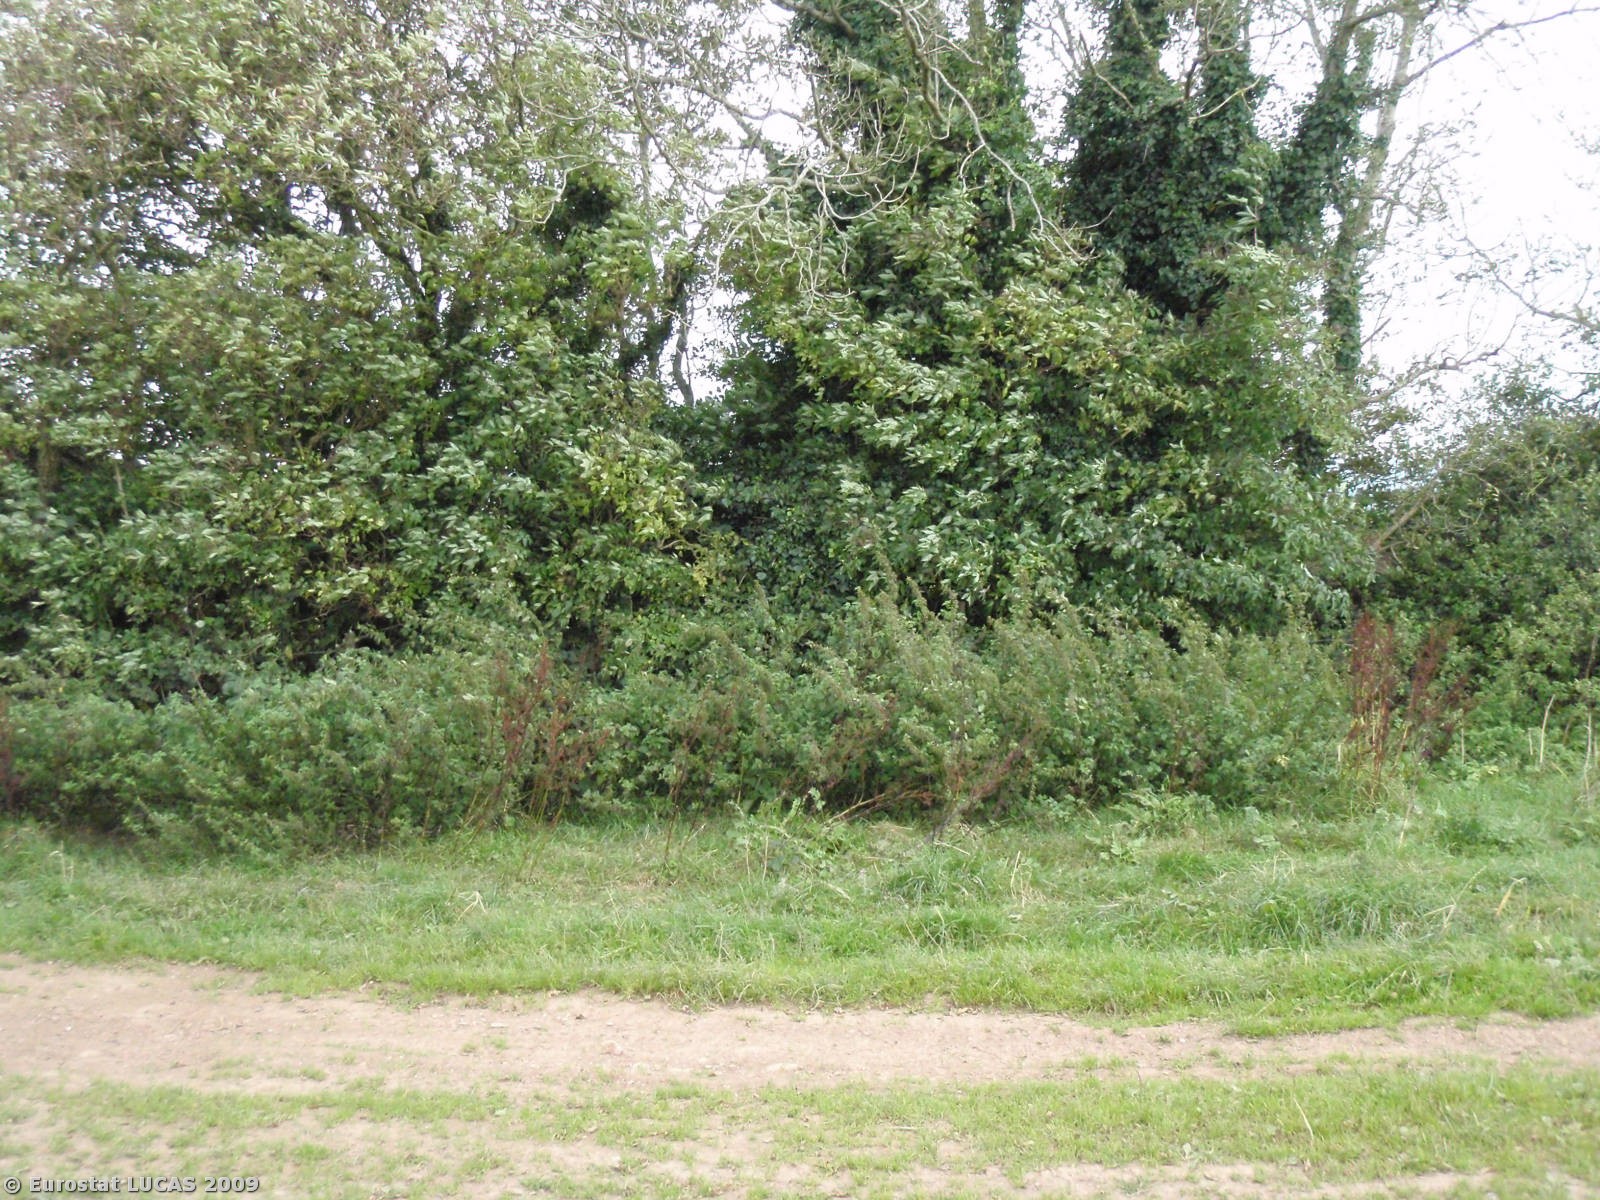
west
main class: Grassland
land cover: Grassland without tree/shrub cover
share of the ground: 50 - 75 %
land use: Agriculture (excluding fallow land and kitchen gardens)
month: September
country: GB
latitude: 51.1162
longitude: -3.4401
